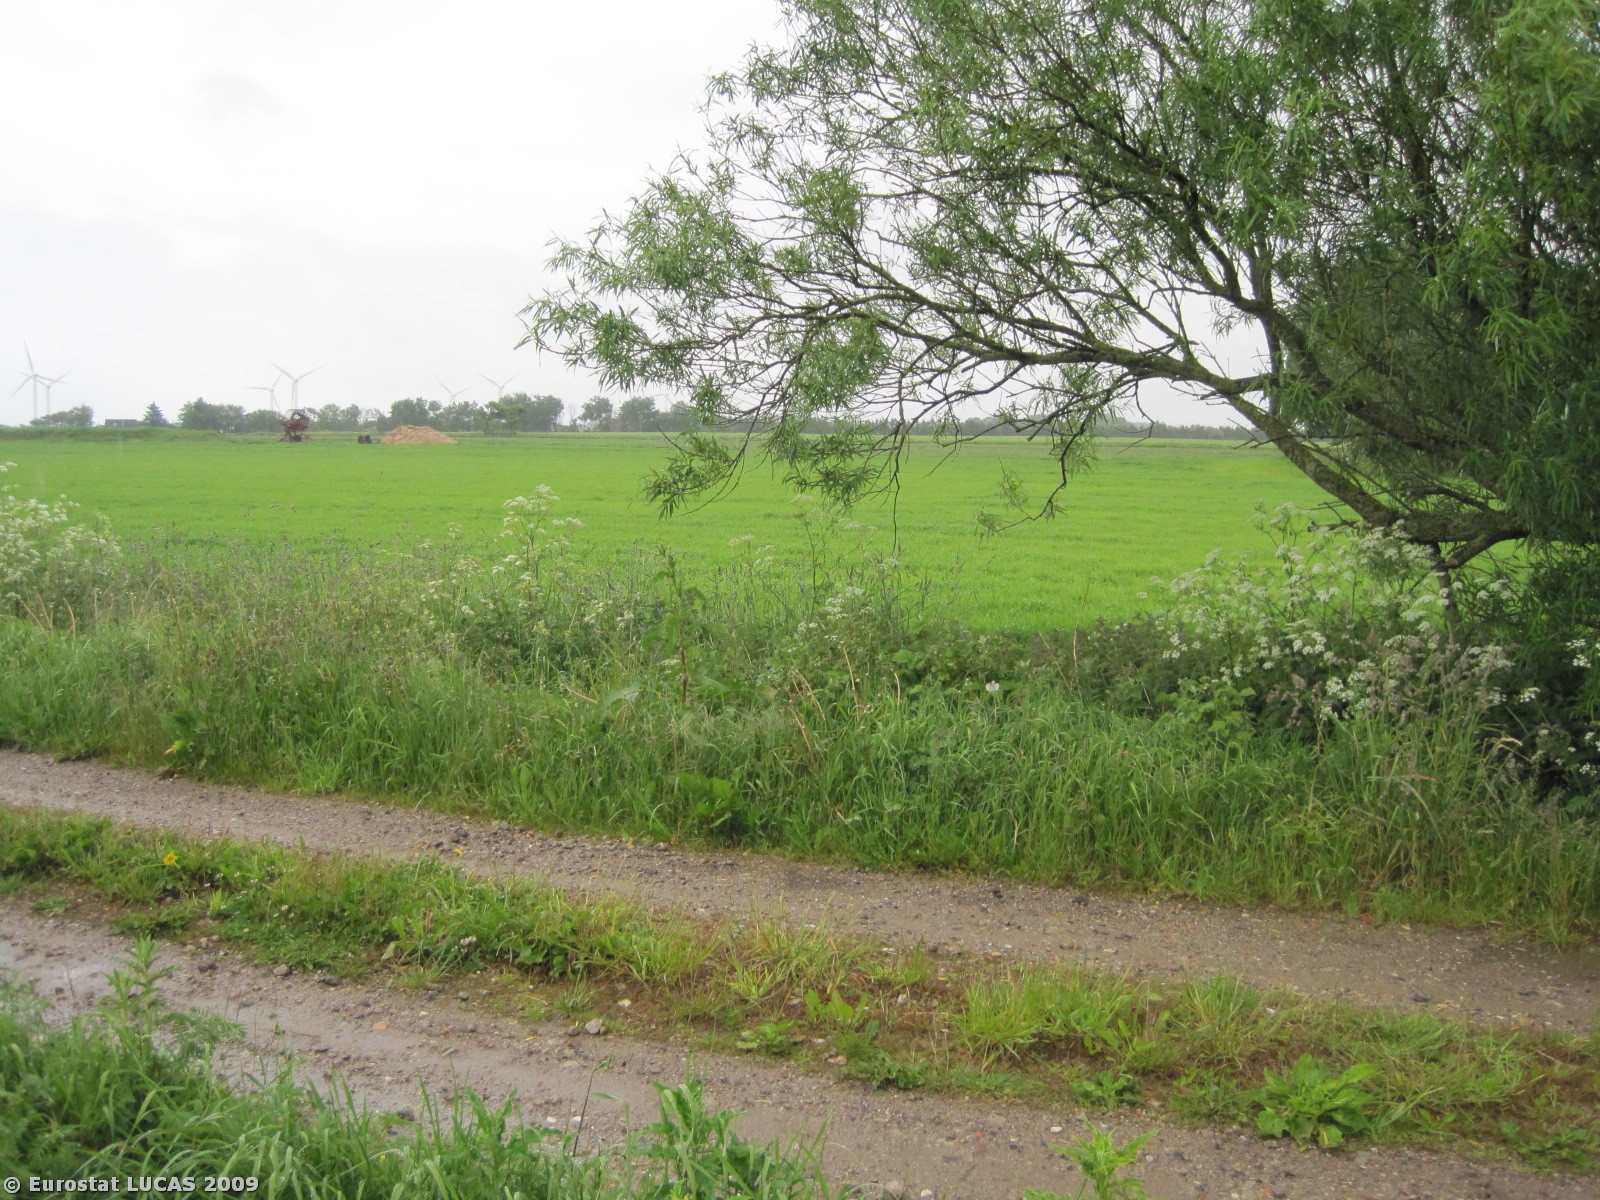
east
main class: Cropland
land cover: Maize
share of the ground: < 10 %
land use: Agriculture (excluding fallow land and kitchen gardens)
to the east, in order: Maize; Grass margins; Tracks; Grass margins; Shrubland with sparse tree cover; Ditches and canals; Grass margins; Barley; Grass margins; Fences; Grassland without tree/shrub cover; Fences; Grassland without tree/shrub cover; Fences; Grass margins; Tracks; Grass margins; Barley
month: June
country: DK
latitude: 57.3922
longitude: 10.0831
